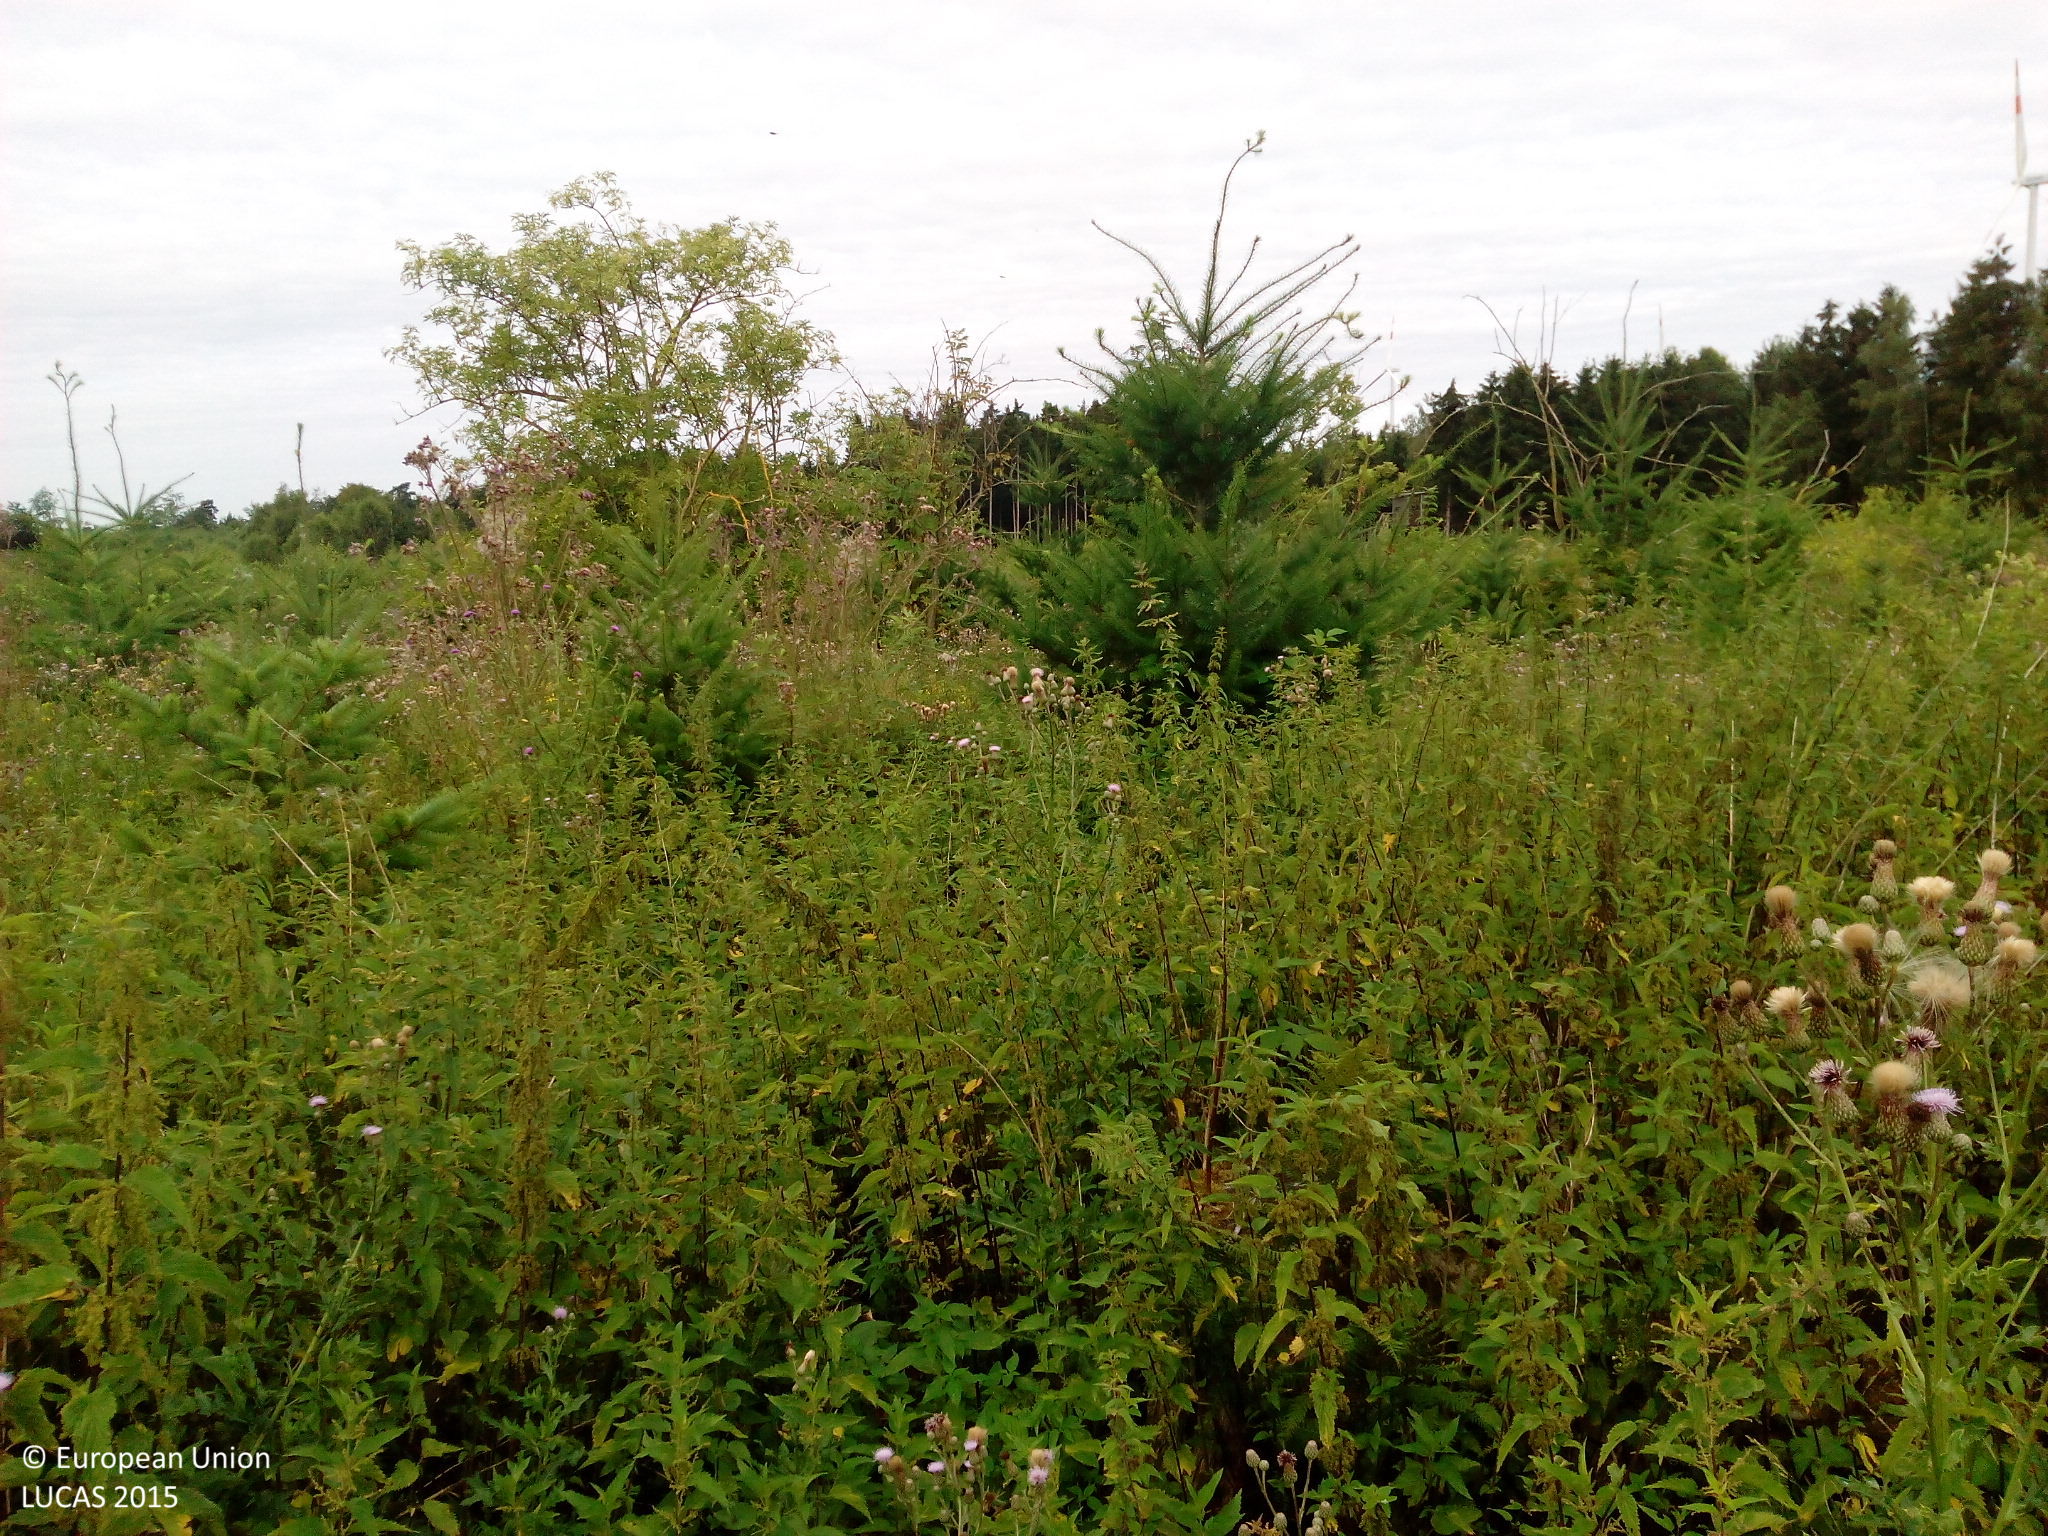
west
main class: Shrubland
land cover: Shrubland with sparse tree cover
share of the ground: 50 - 75 %
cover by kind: shrubs 65 %, herbaceous plants 30 %, coniferous forest trees 5 %
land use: Forestry
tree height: < 5 m
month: July
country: DE
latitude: 49.8241
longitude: 7.1228
